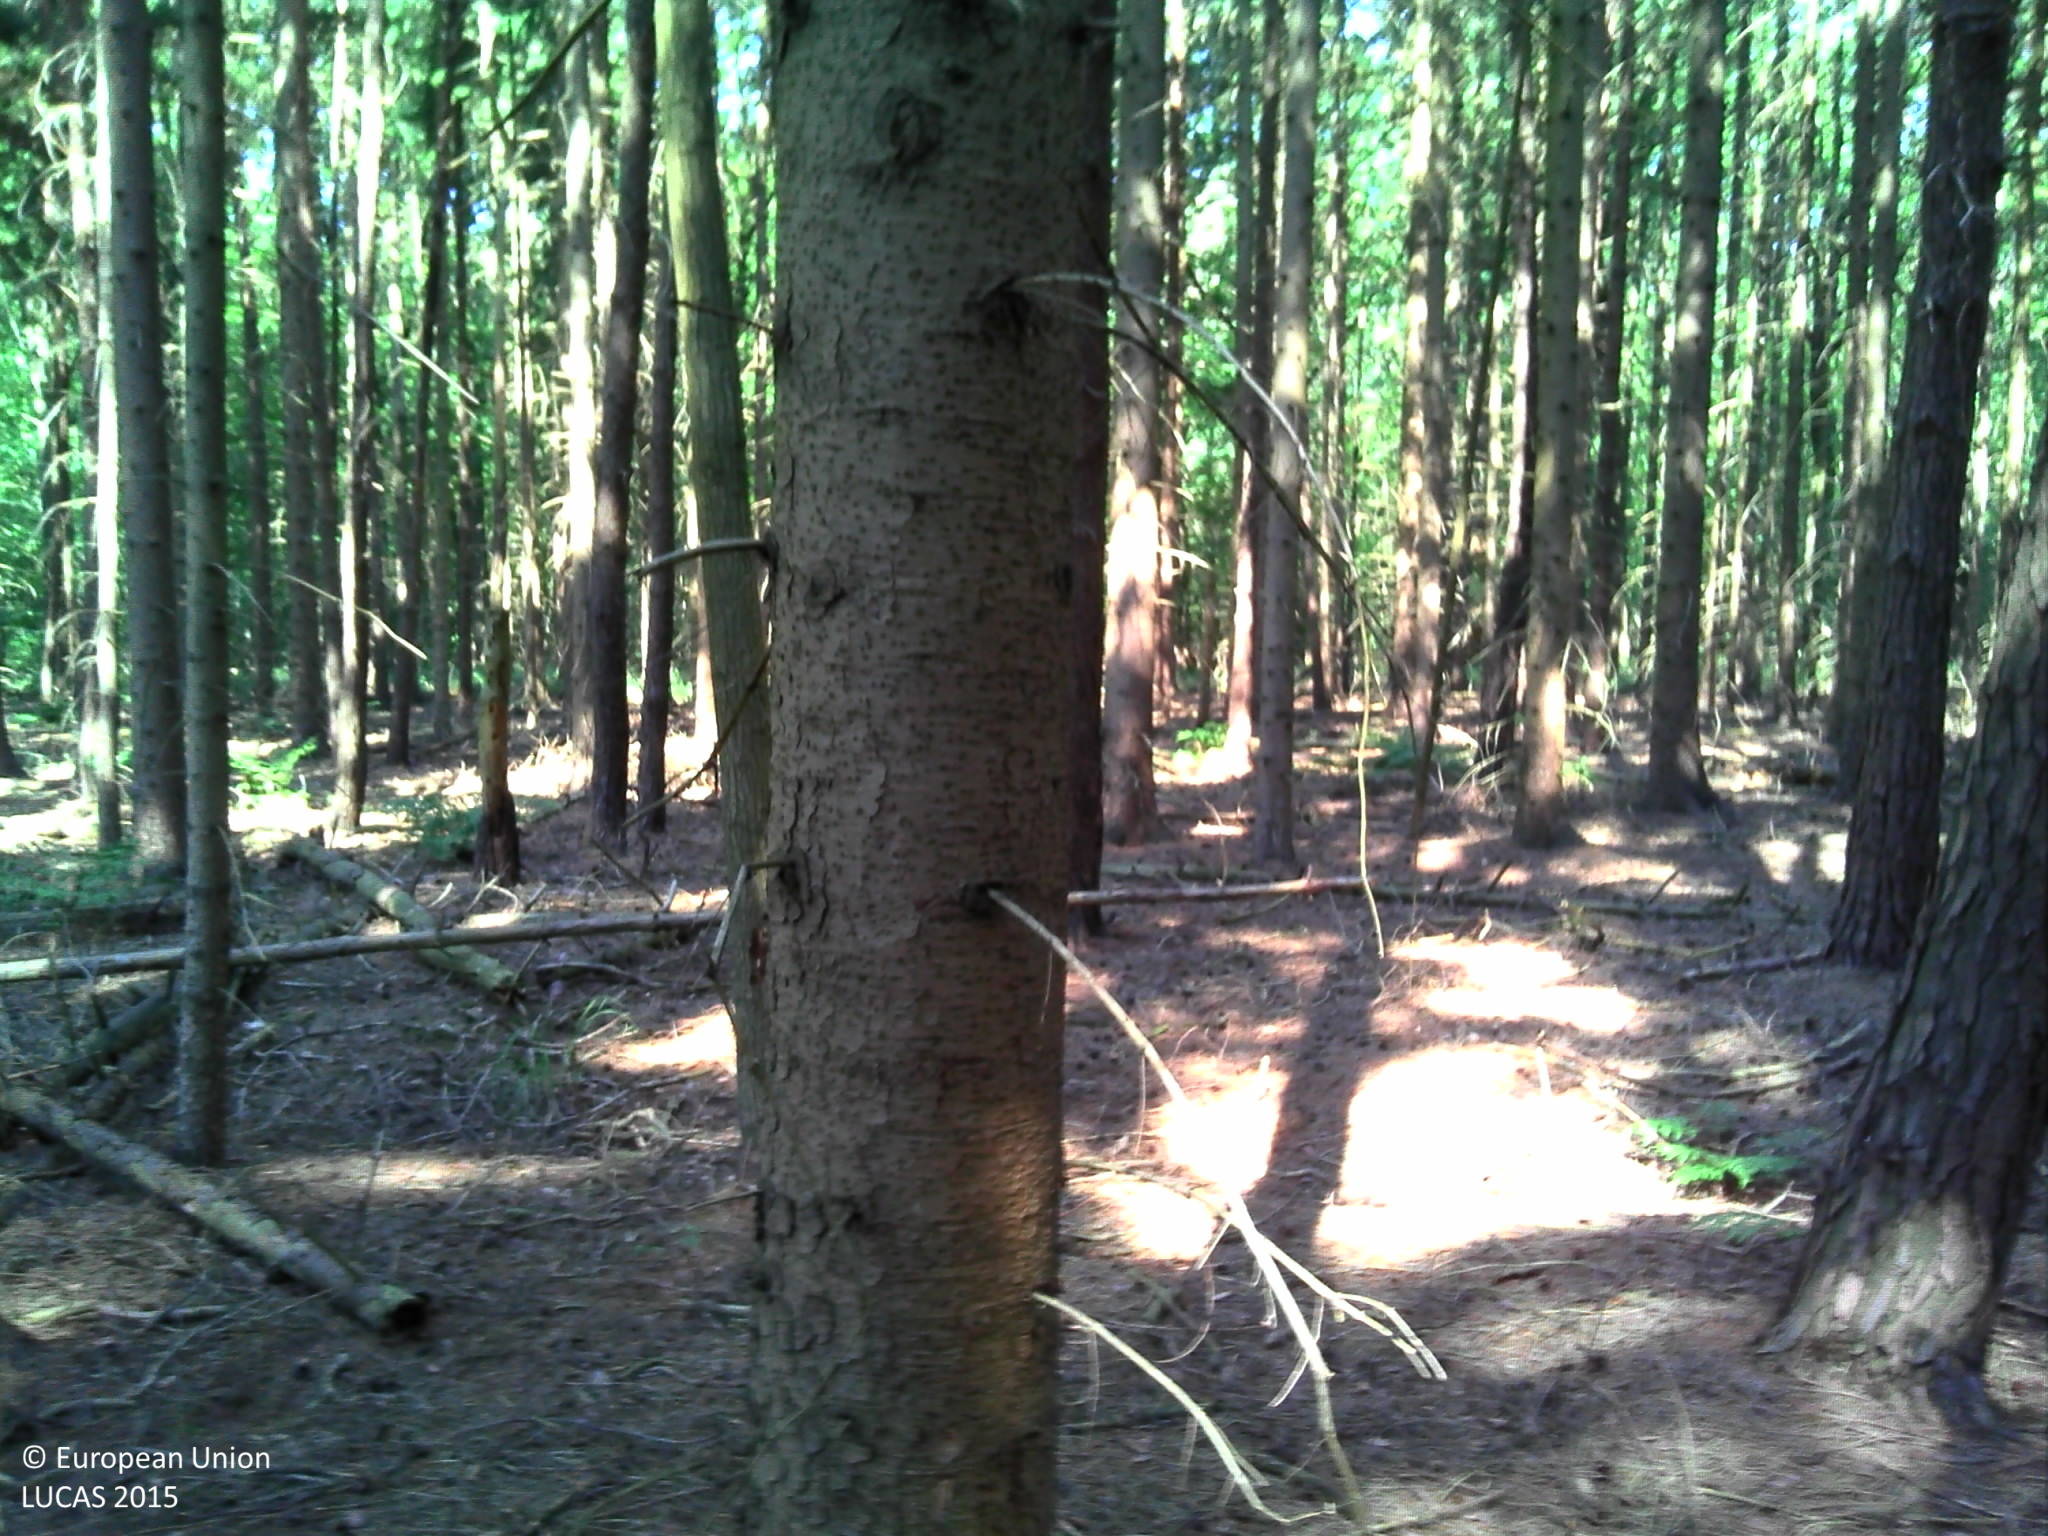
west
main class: Woodland
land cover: Pine dominated coniferous woodland
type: exotic forest
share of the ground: > 75 %
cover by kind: coniferous forest trees 90 %, unconsolidated bare surface 10 %
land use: Forestry
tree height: > 5 m
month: July
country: BE
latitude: 51.1509
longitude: 3.4586
